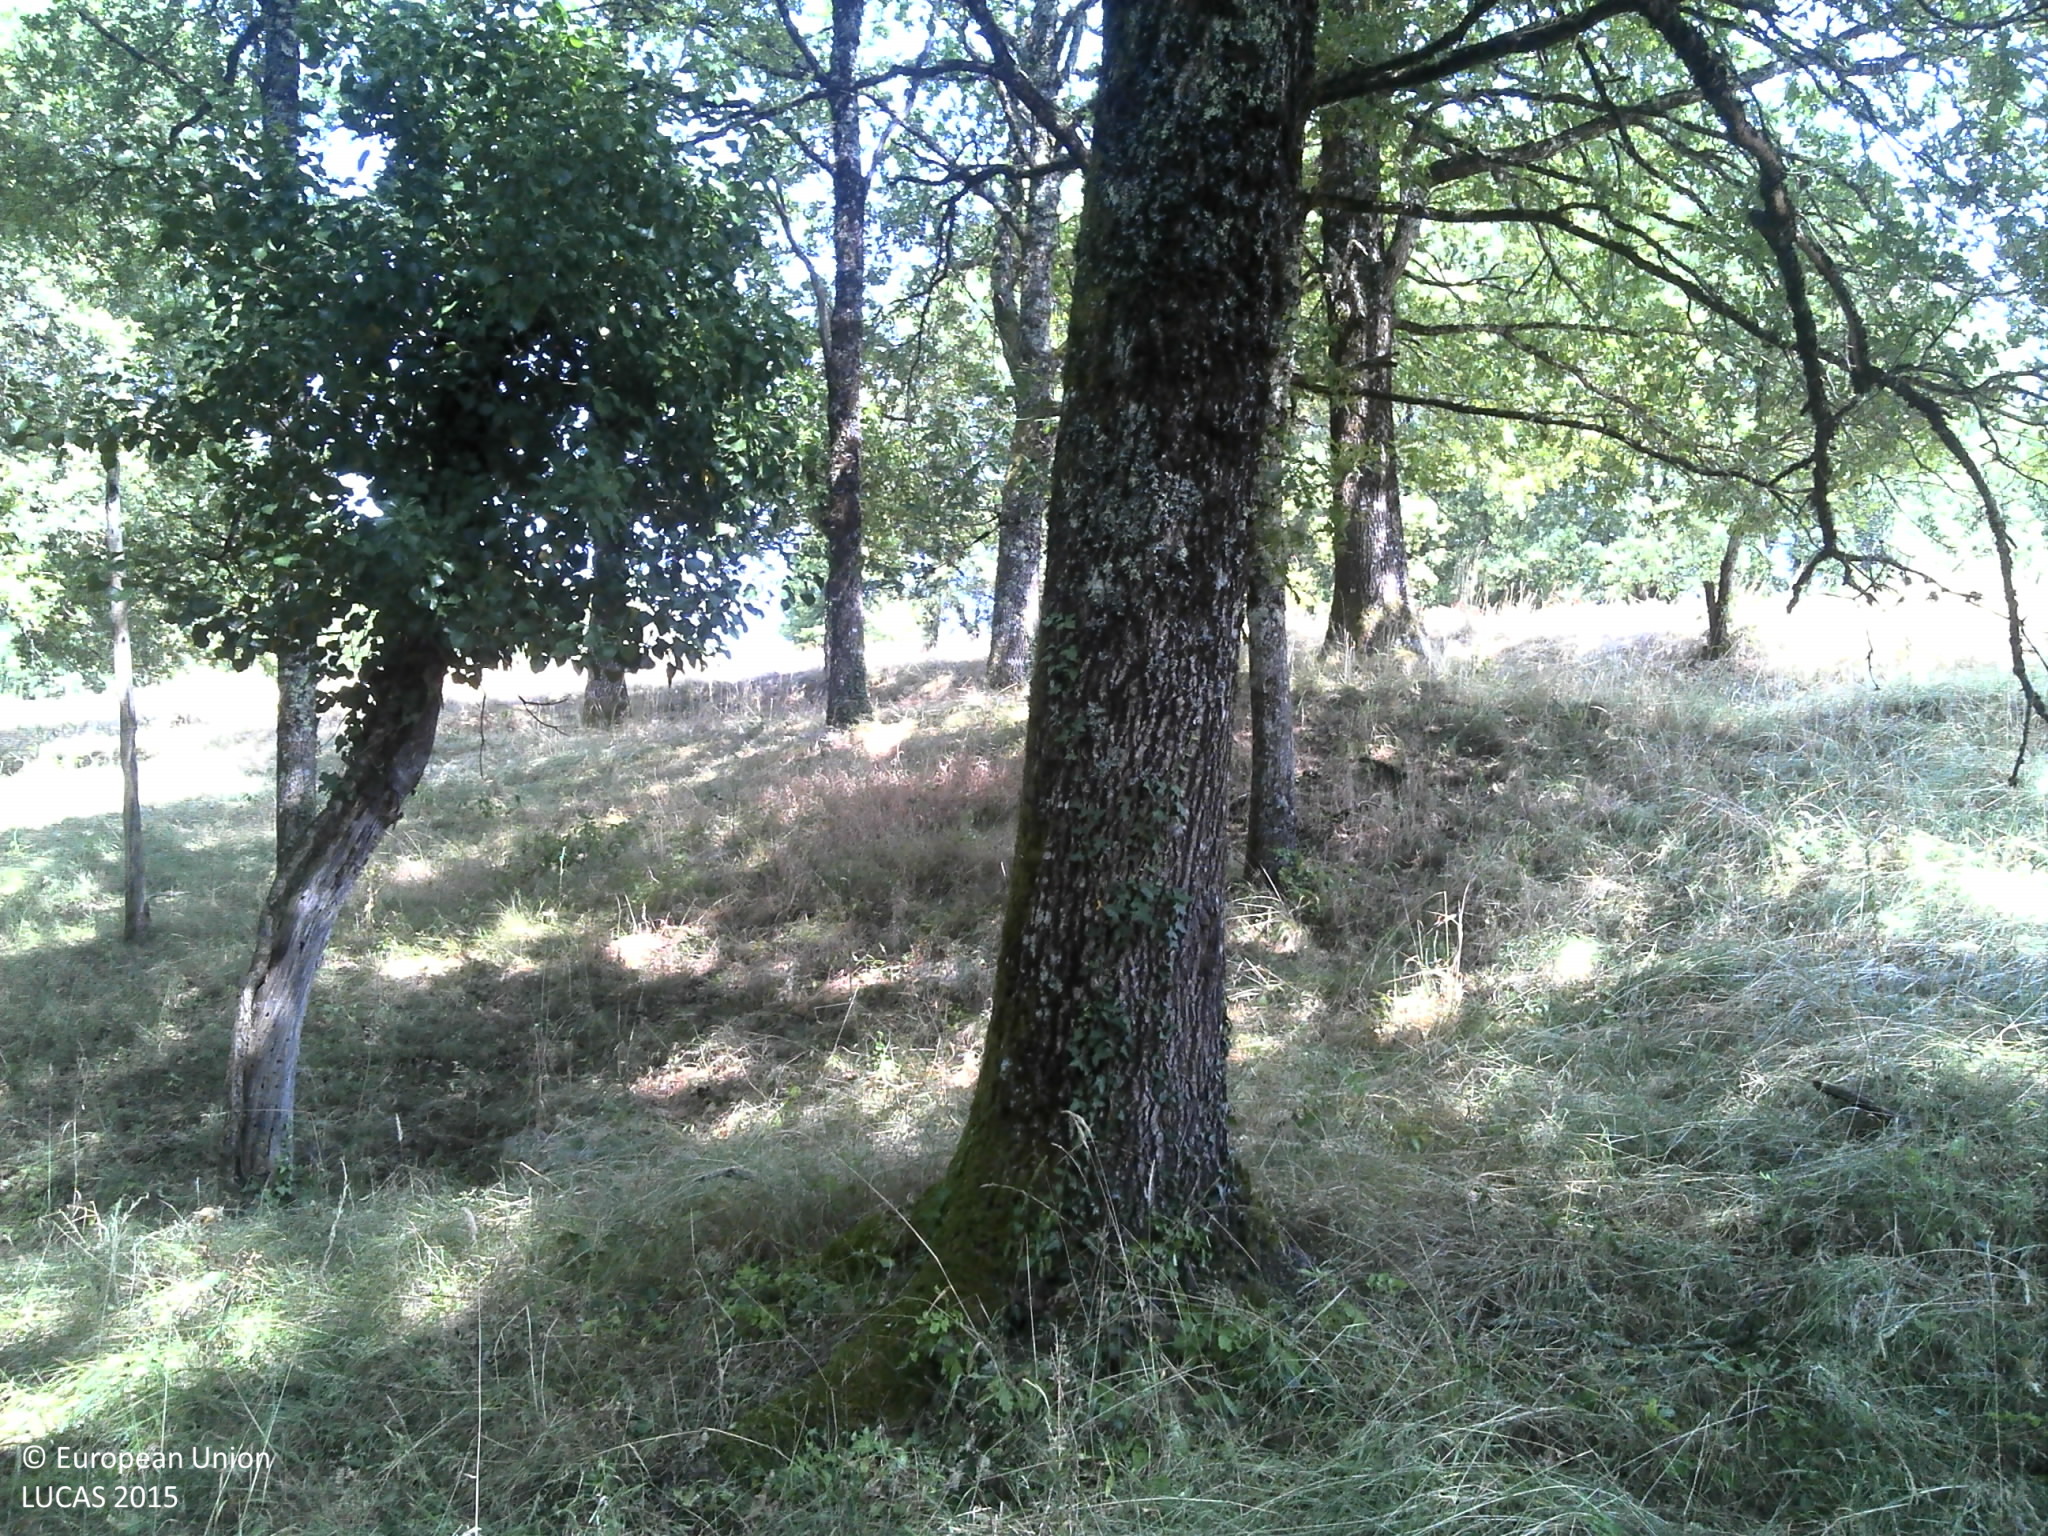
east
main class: Woodland
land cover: Broadleaved woodland
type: thermophilous deciduous forest
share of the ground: > 75 %
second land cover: Grassland without tree/shrub cover
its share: > 75 %
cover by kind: broadleaved forest trees 50 %, herbaceous plants 45 %, lichens and mosses 5 %
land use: Forestry
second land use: Agriculture (excluding fallow land and kitchen gardens)
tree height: > 5 m
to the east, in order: Broadleaved woodland; Grassland without tree/shrub cover; Fences; Broadleaved woodland; Fences; Grassland without tree/shrub cover; Fences; Grassland without tree/shrub cover; Abandoned hedges; Grassland without tree/shrub cover; Fences; Ditches and canals; Paved roads, cycling and walking lanes; Electric lines; Ditches and canals; Fences; Grassland without tree/shrub cover
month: July
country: FR
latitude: 45.0727
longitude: 1.7533
